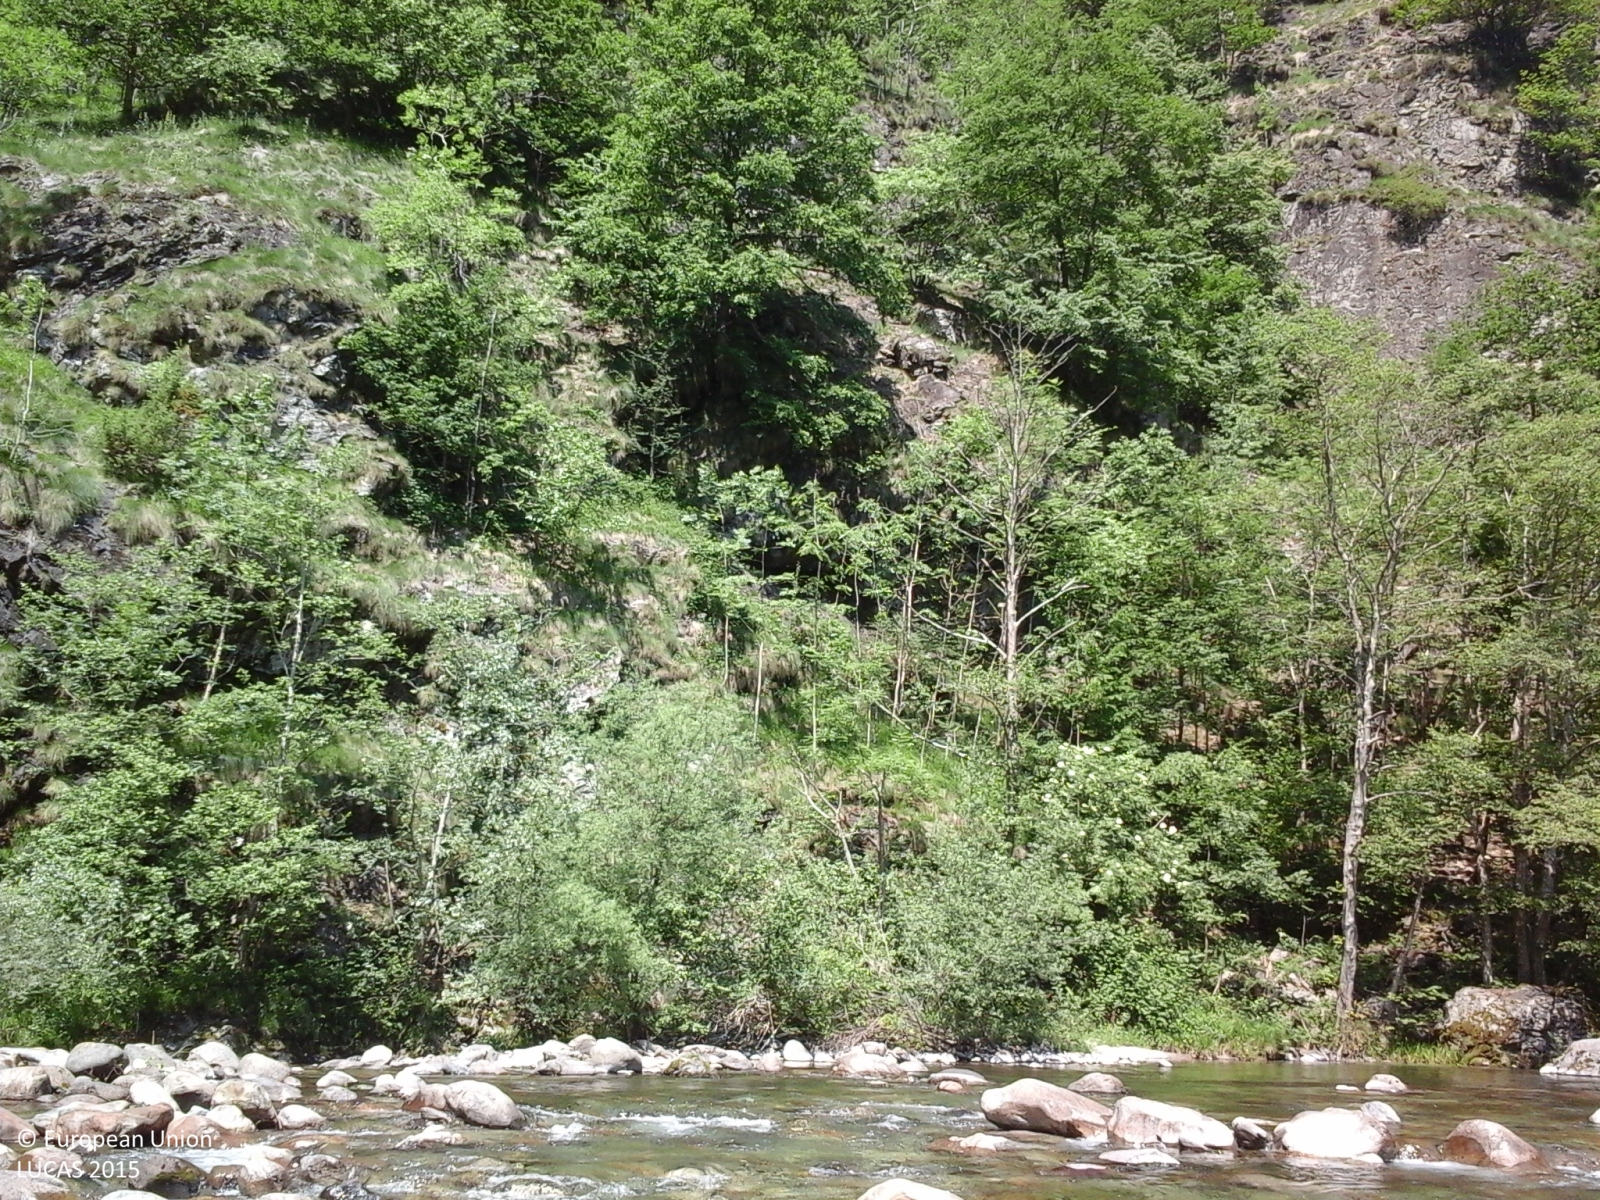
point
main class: Woodland
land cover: Broadleaved woodland
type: mesophytic deciduous forest
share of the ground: > 75 %
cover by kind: broadleaved forest trees 100 %
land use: Forestry
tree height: > 5 m
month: June
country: IT
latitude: 45.8673
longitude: 8.1863
